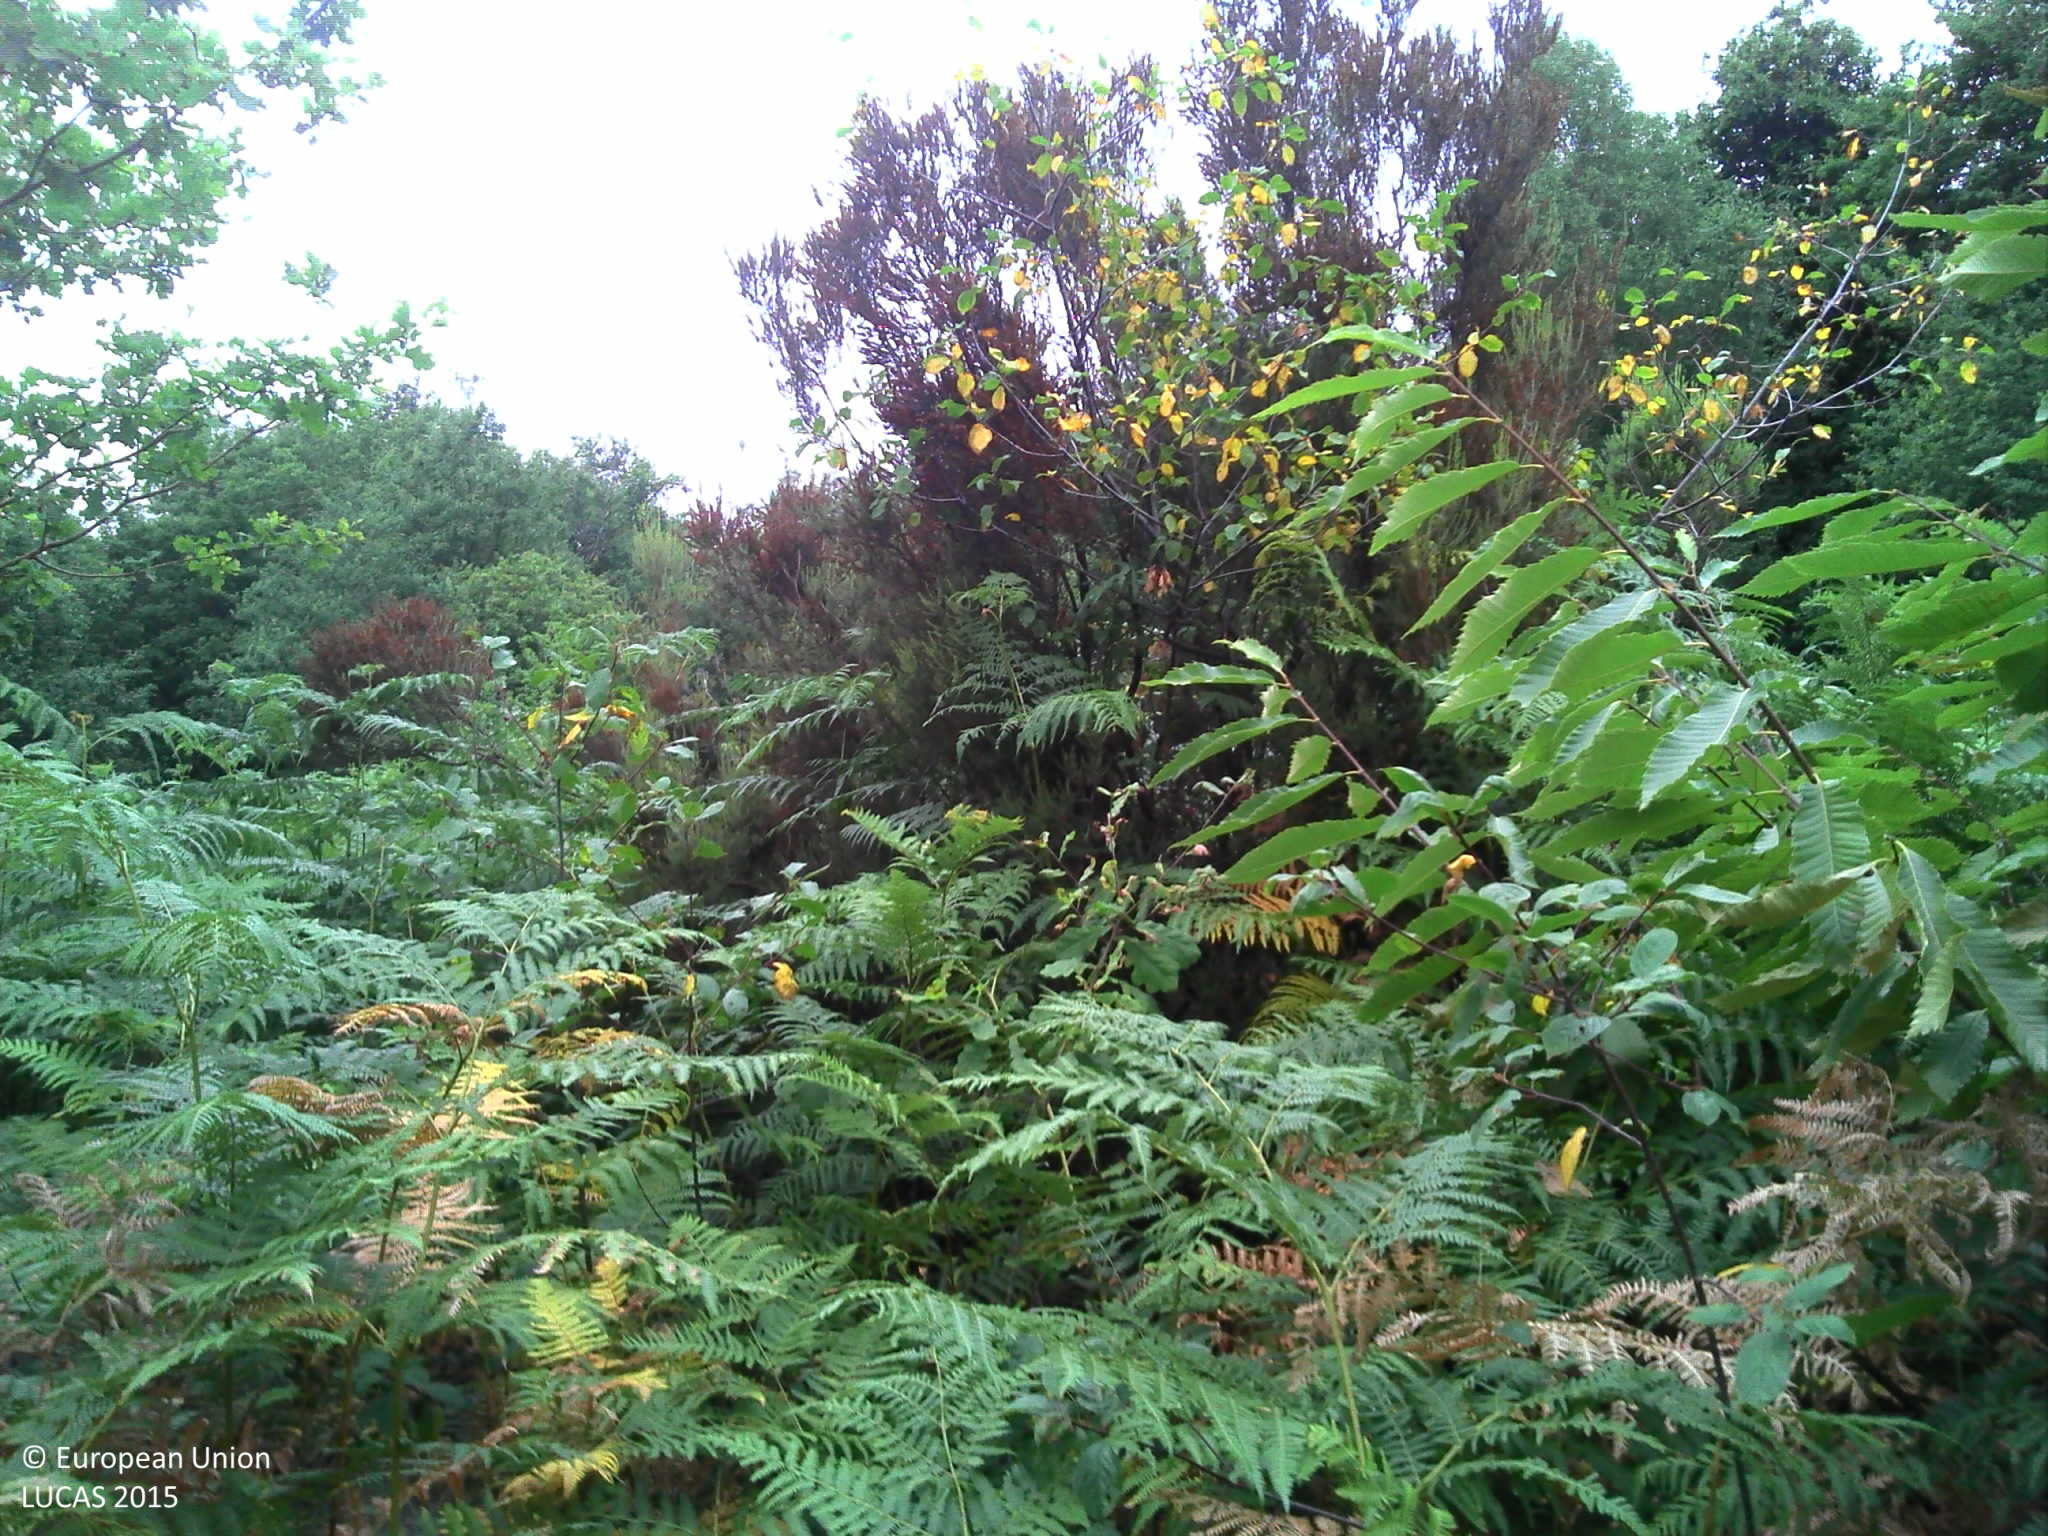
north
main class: Woodland
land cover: Broadleaved woodland
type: acidophilous oak and oak-birch forest
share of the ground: > 75 %
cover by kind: herbaceous plants 55 %, broadleaved forest trees 35 %, consolidated bare surface 10 %
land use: Forestry
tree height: > 5 m
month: July
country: FR
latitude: 45.5788
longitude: 1.2903
